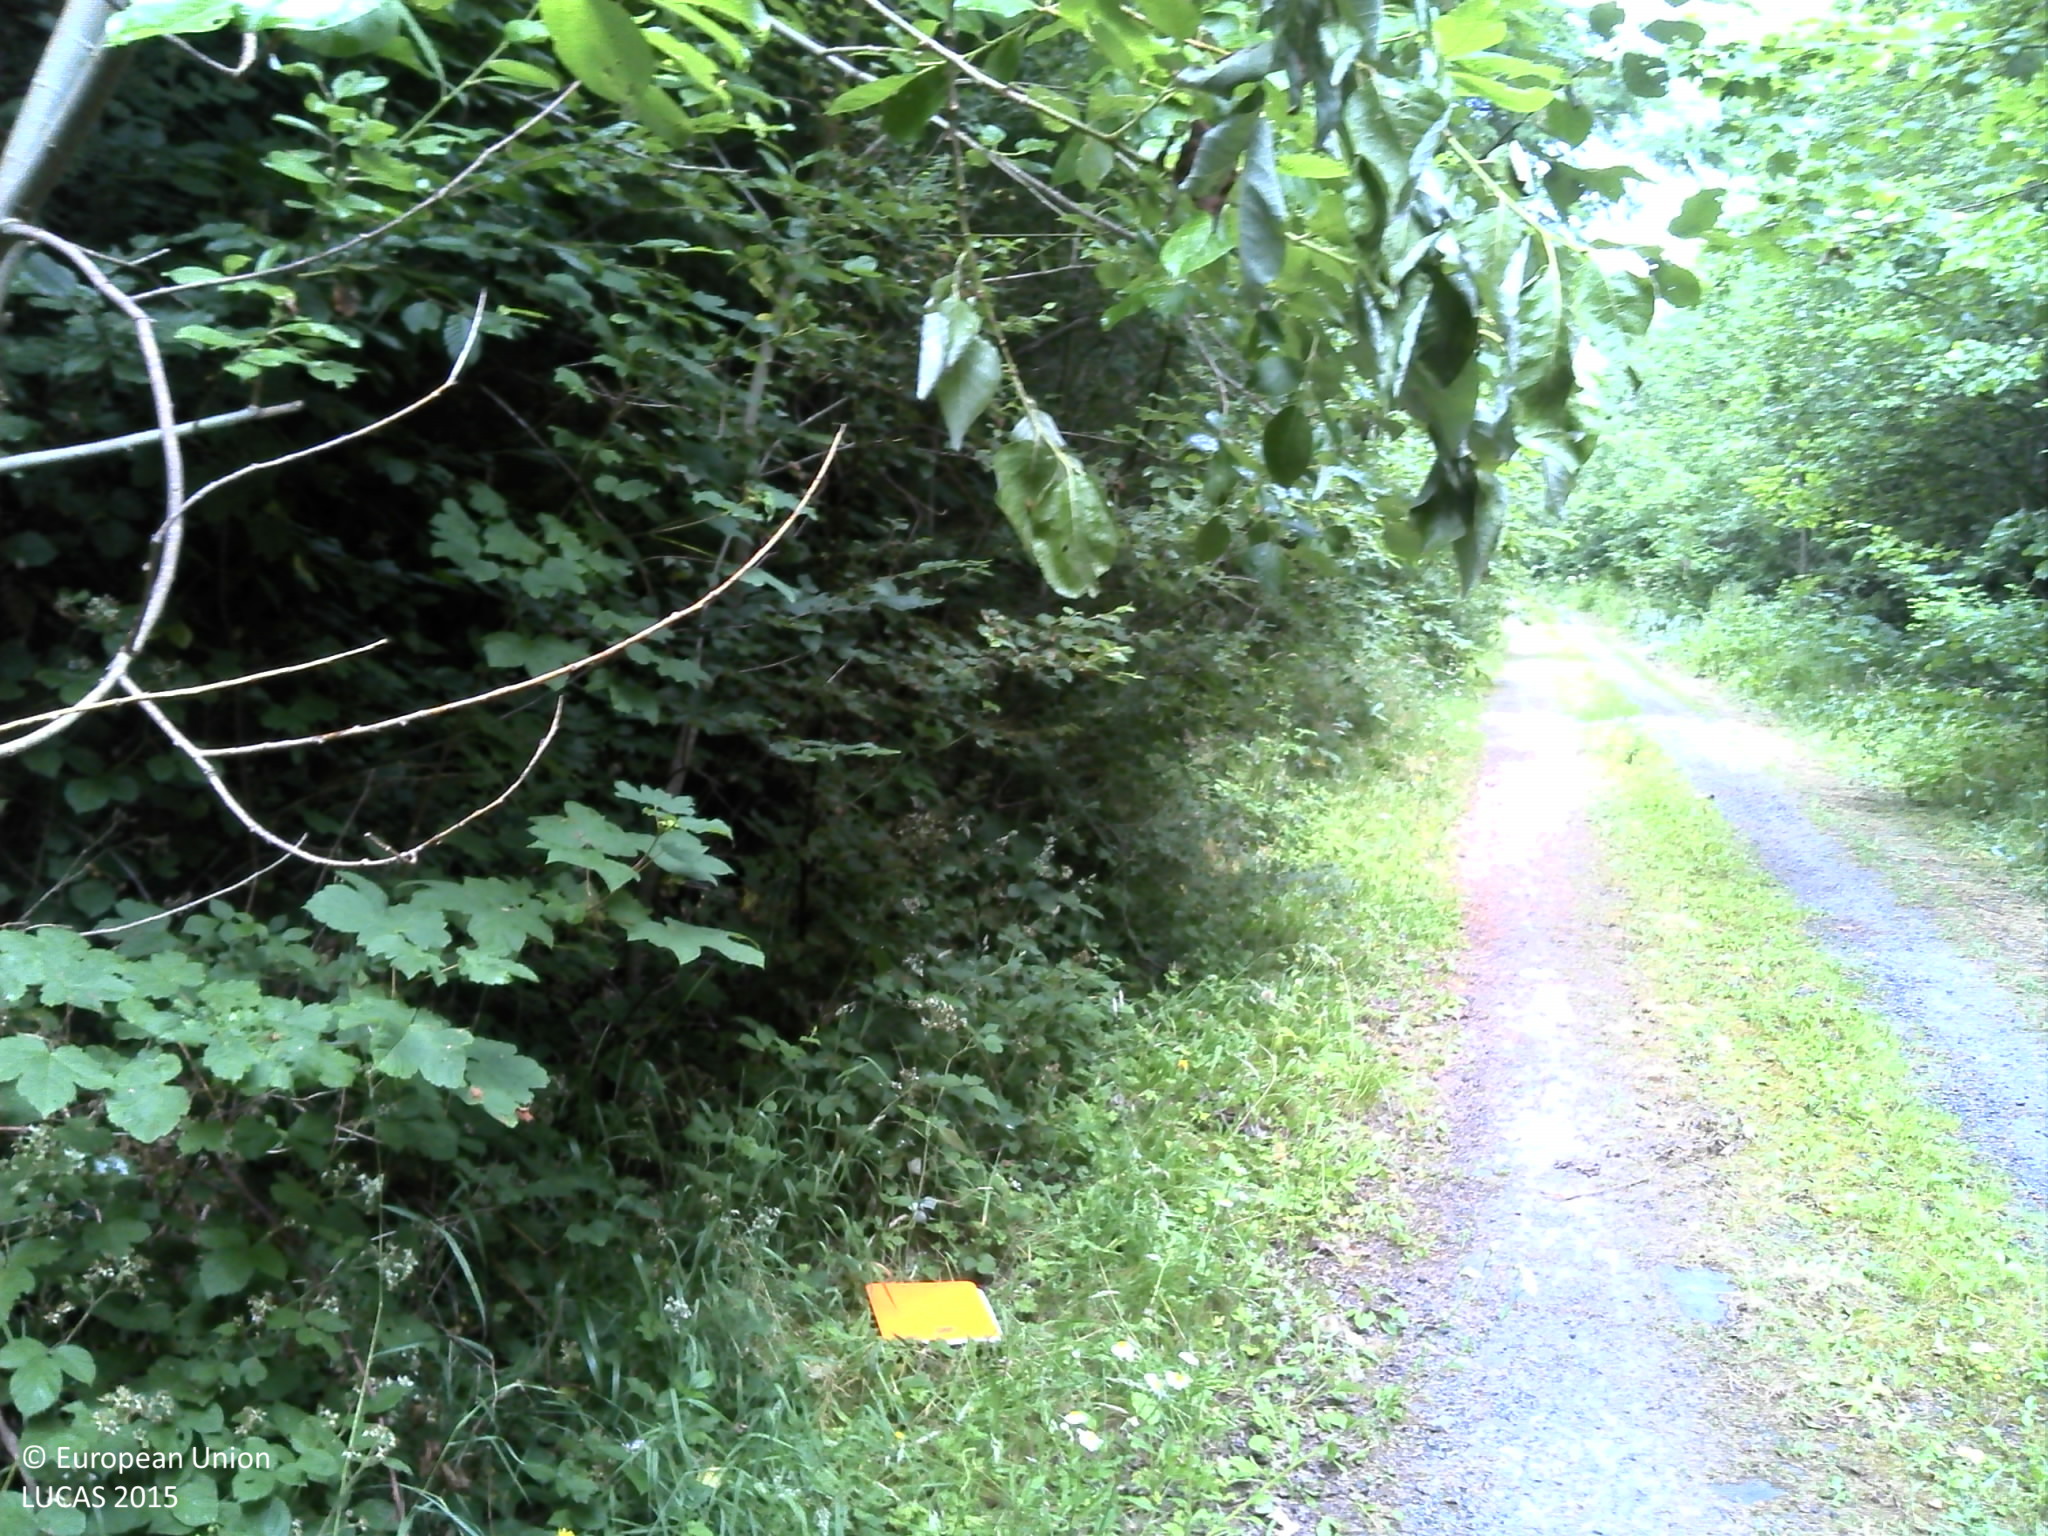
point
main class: Woodland
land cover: Broadleaved woodland
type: mesophytic deciduous forest
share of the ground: > 75 %
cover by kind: broadleaved forest trees 70 %, herbaceous plants 25 %, consolidated bare surface 5 %
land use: Forestry
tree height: > 5 m
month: July
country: FR
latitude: 49.8319
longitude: 4.8113
